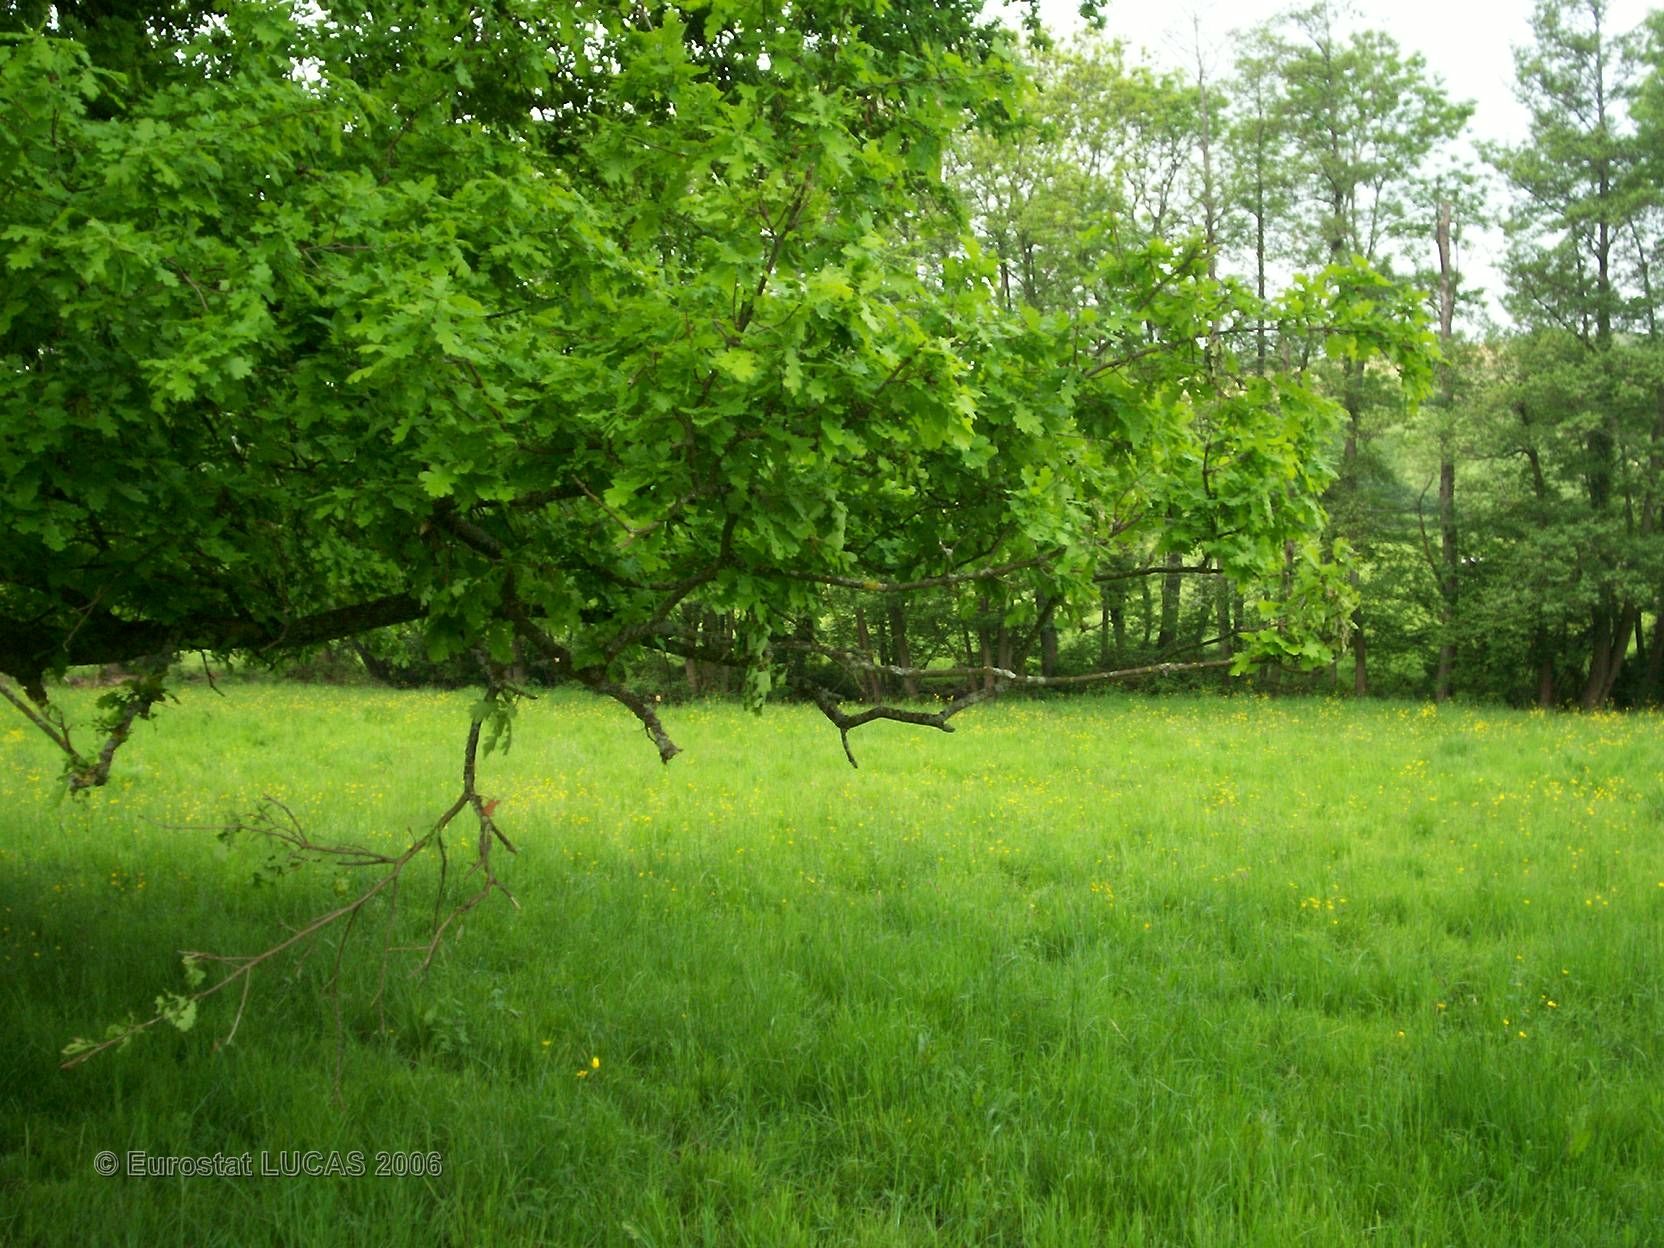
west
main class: Grassland
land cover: Grassland with sparse tree/shrub cover
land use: Agriculture (excluding fallow land and kitchen gardens)
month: May
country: FR
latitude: 46.5110
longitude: 4.7495
